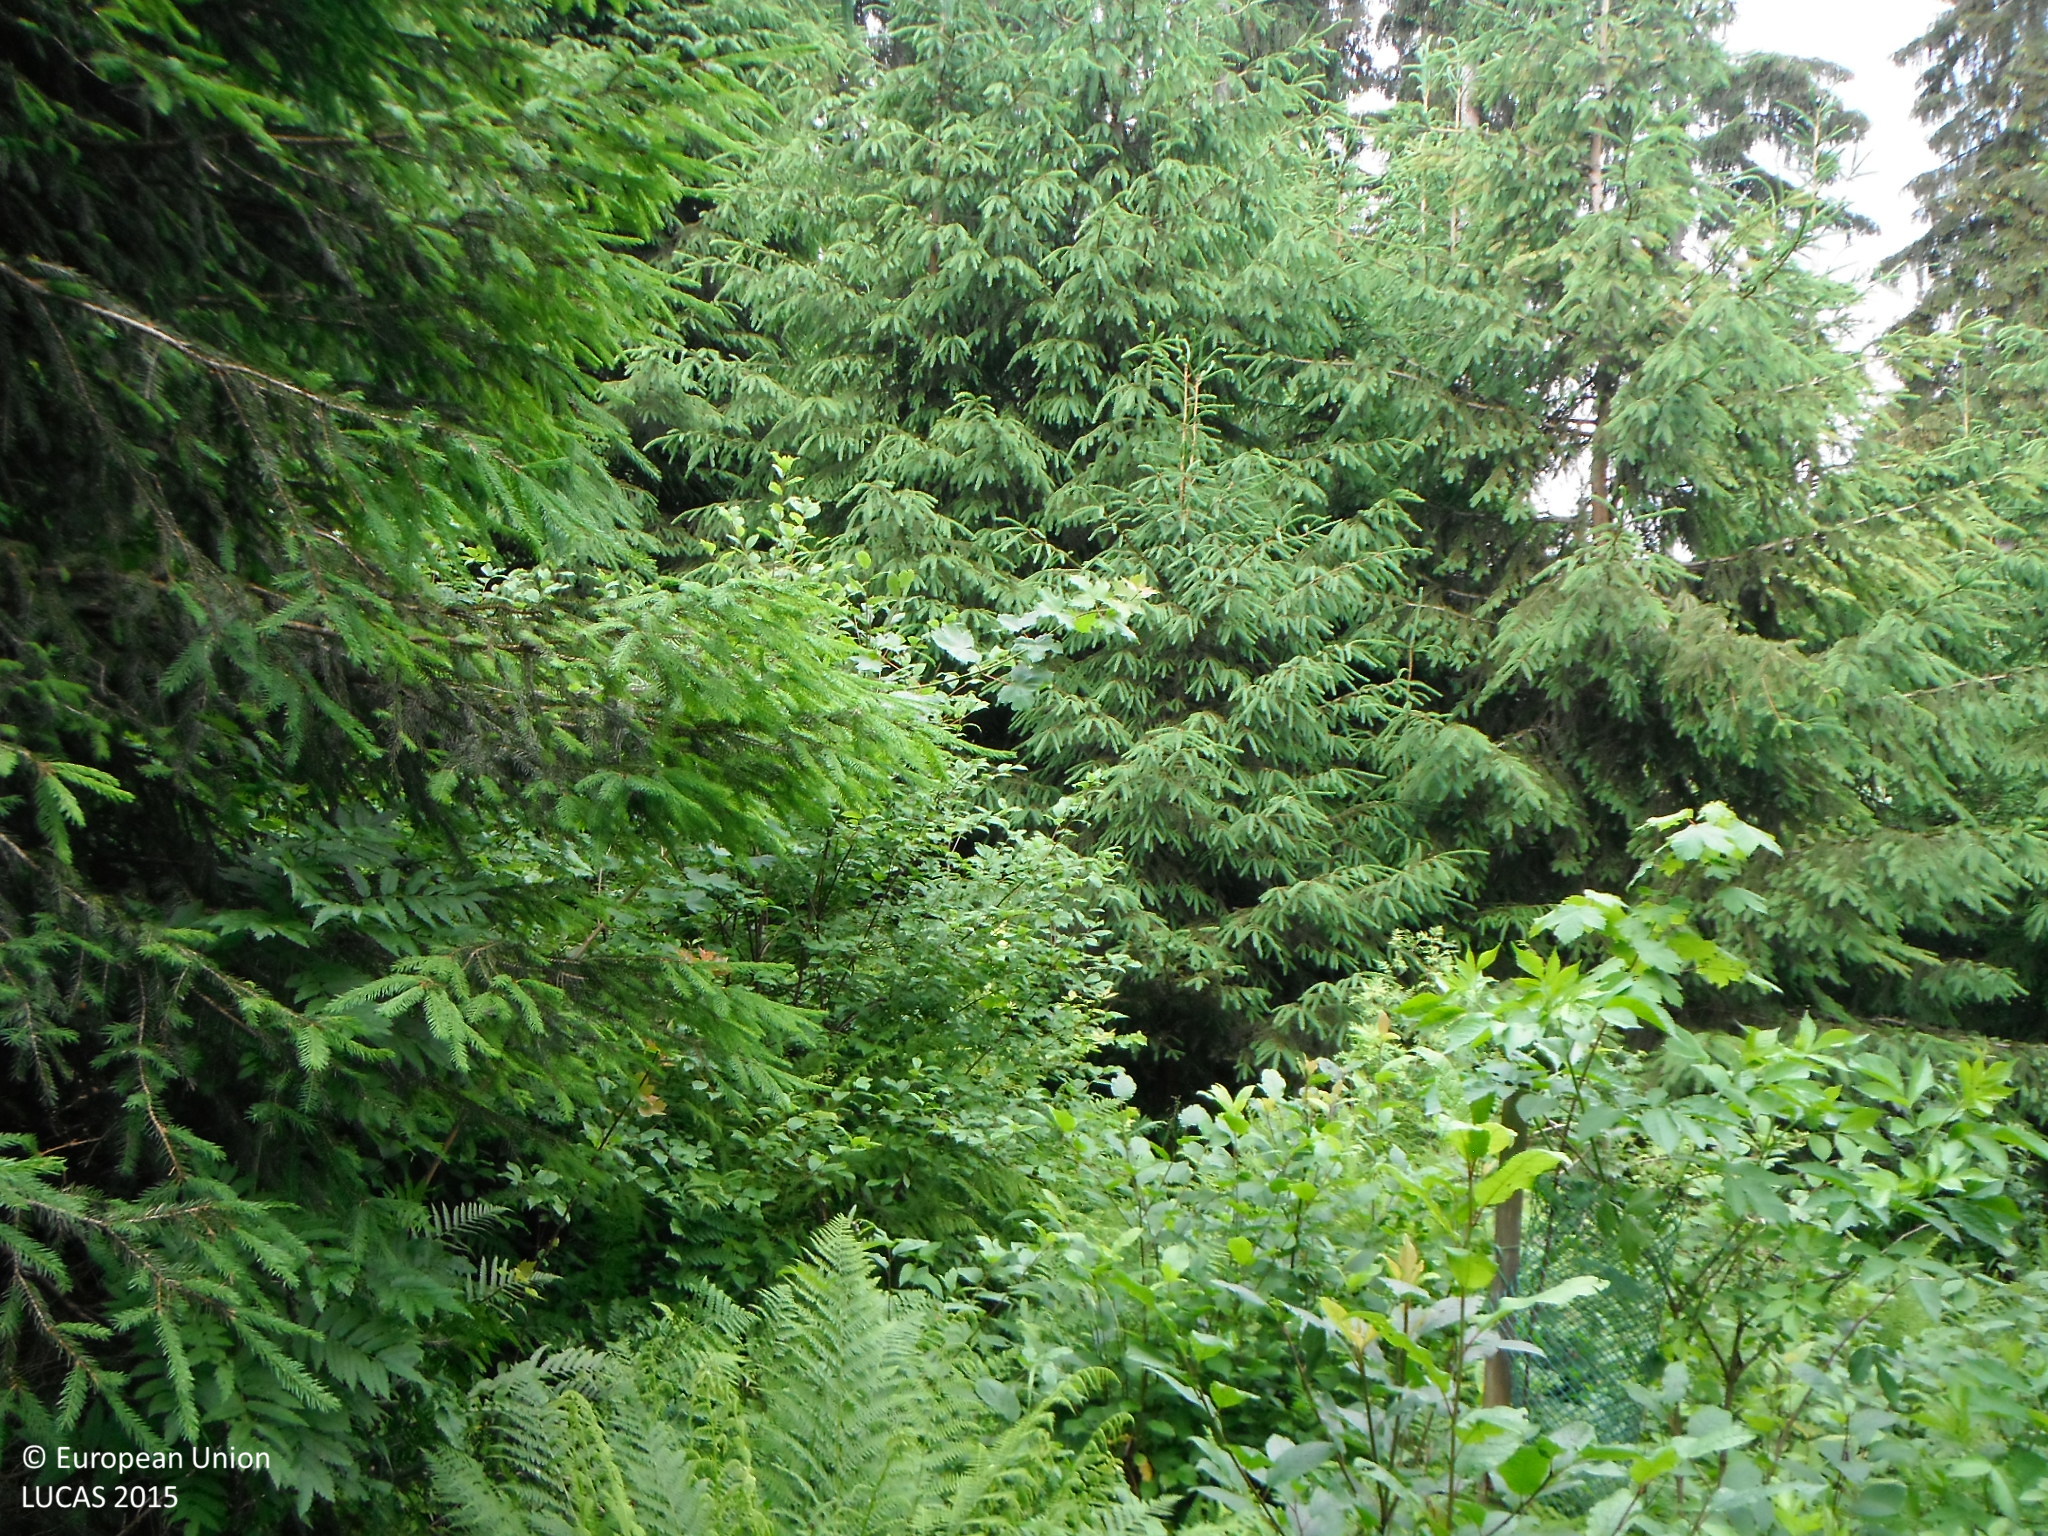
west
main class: Woodland
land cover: Spruce dominated coniferous woodland
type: hemiboreal forest and nemoral coniferous forest and mixed broadleaved-coniferous forest
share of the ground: 50 - 75 %
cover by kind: coniferous forest trees 65 %, shrubs 15 %, herbaceous plants 15 %, broadleaved forest trees 5 %
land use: Forestry
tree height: > 5 m
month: June
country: SK
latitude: 49.2000
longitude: 19.3712
